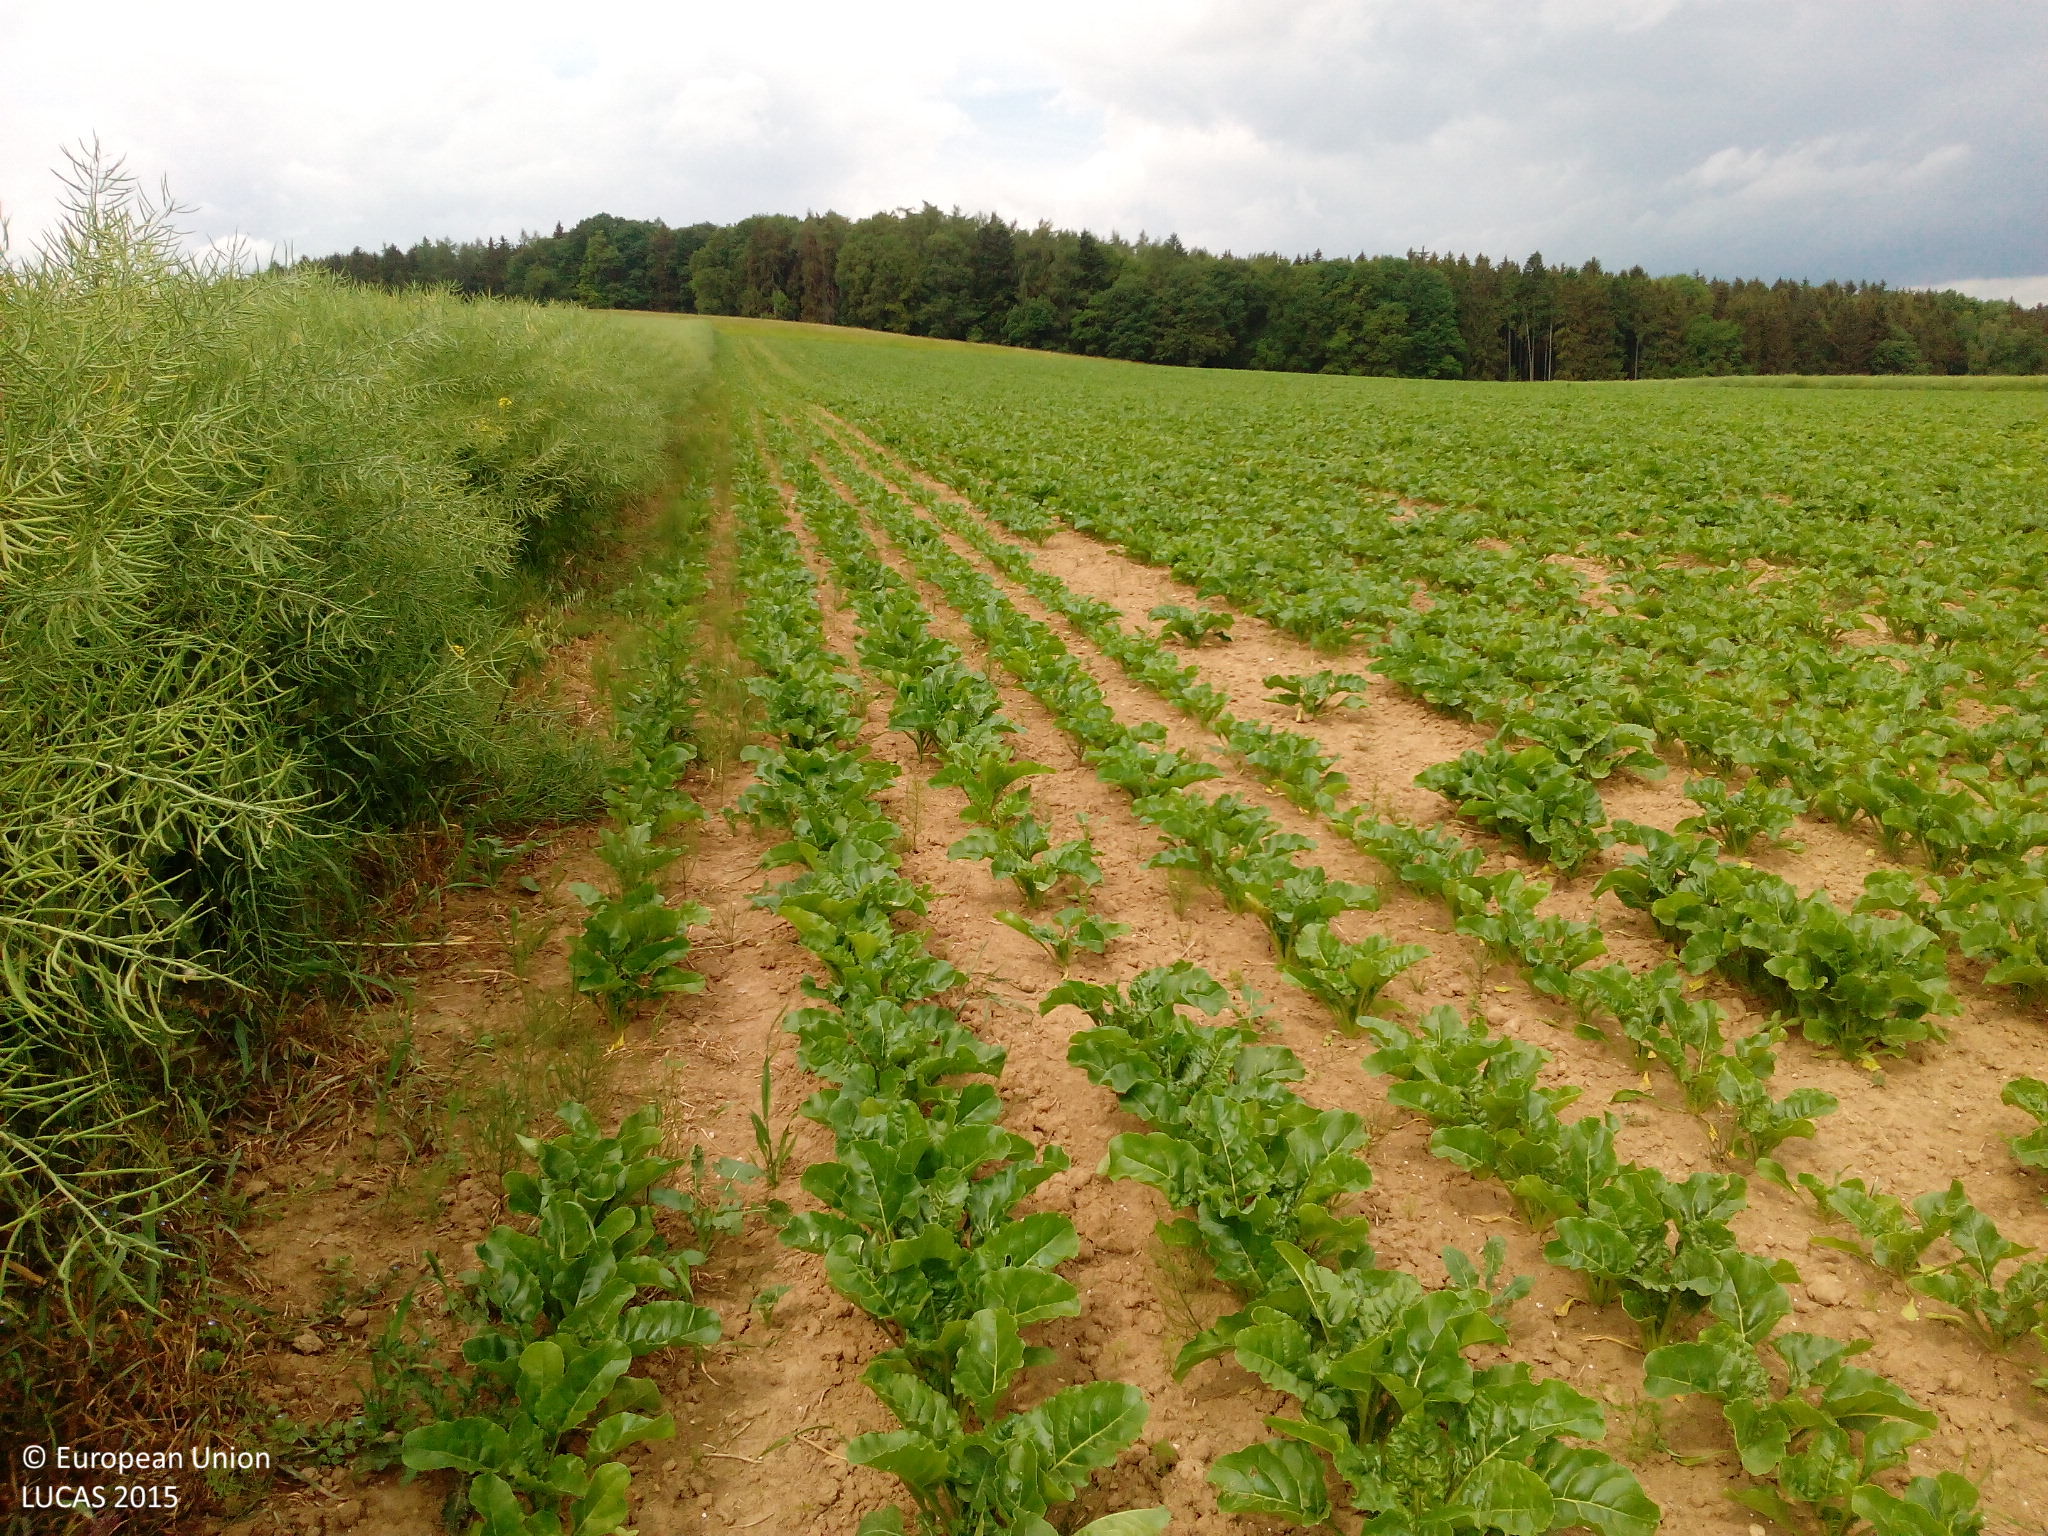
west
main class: Cropland
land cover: Rape and turnip rape
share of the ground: > 75 %
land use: Agriculture (excluding fallow land and kitchen gardens)
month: June
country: DE
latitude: 48.9777
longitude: 12.0898
